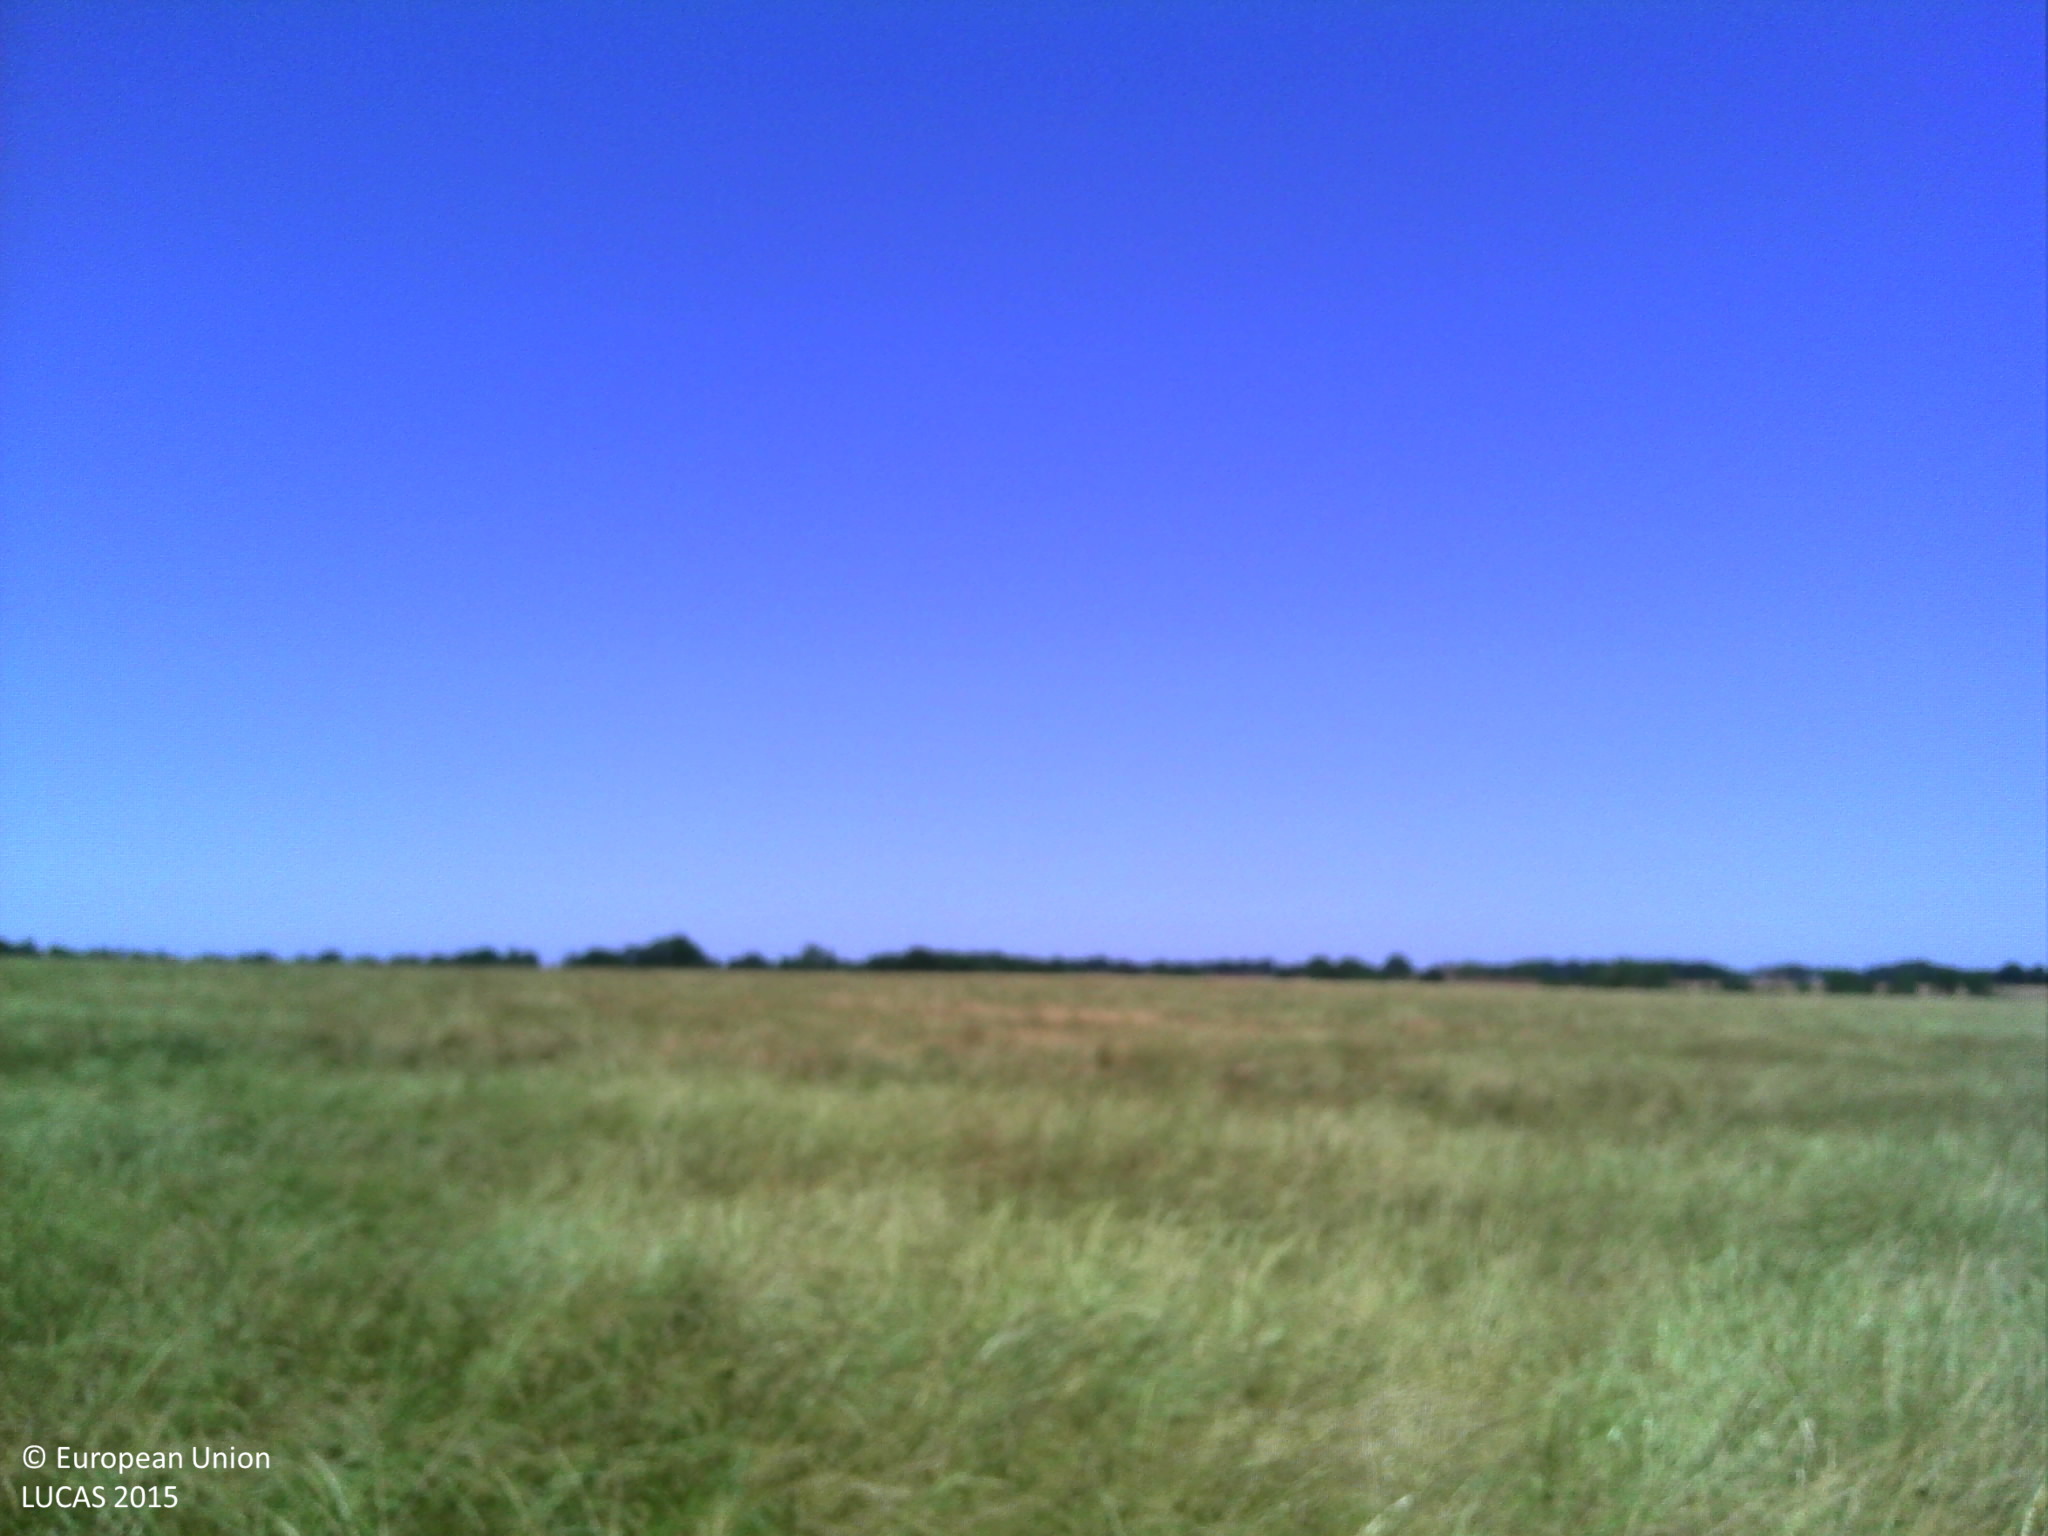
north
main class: Cropland
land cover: Durum wheat
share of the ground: > 75 %
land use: Agriculture (excluding fallow land and kitchen gardens)
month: July
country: FR
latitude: 48.2146
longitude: 0.5420
